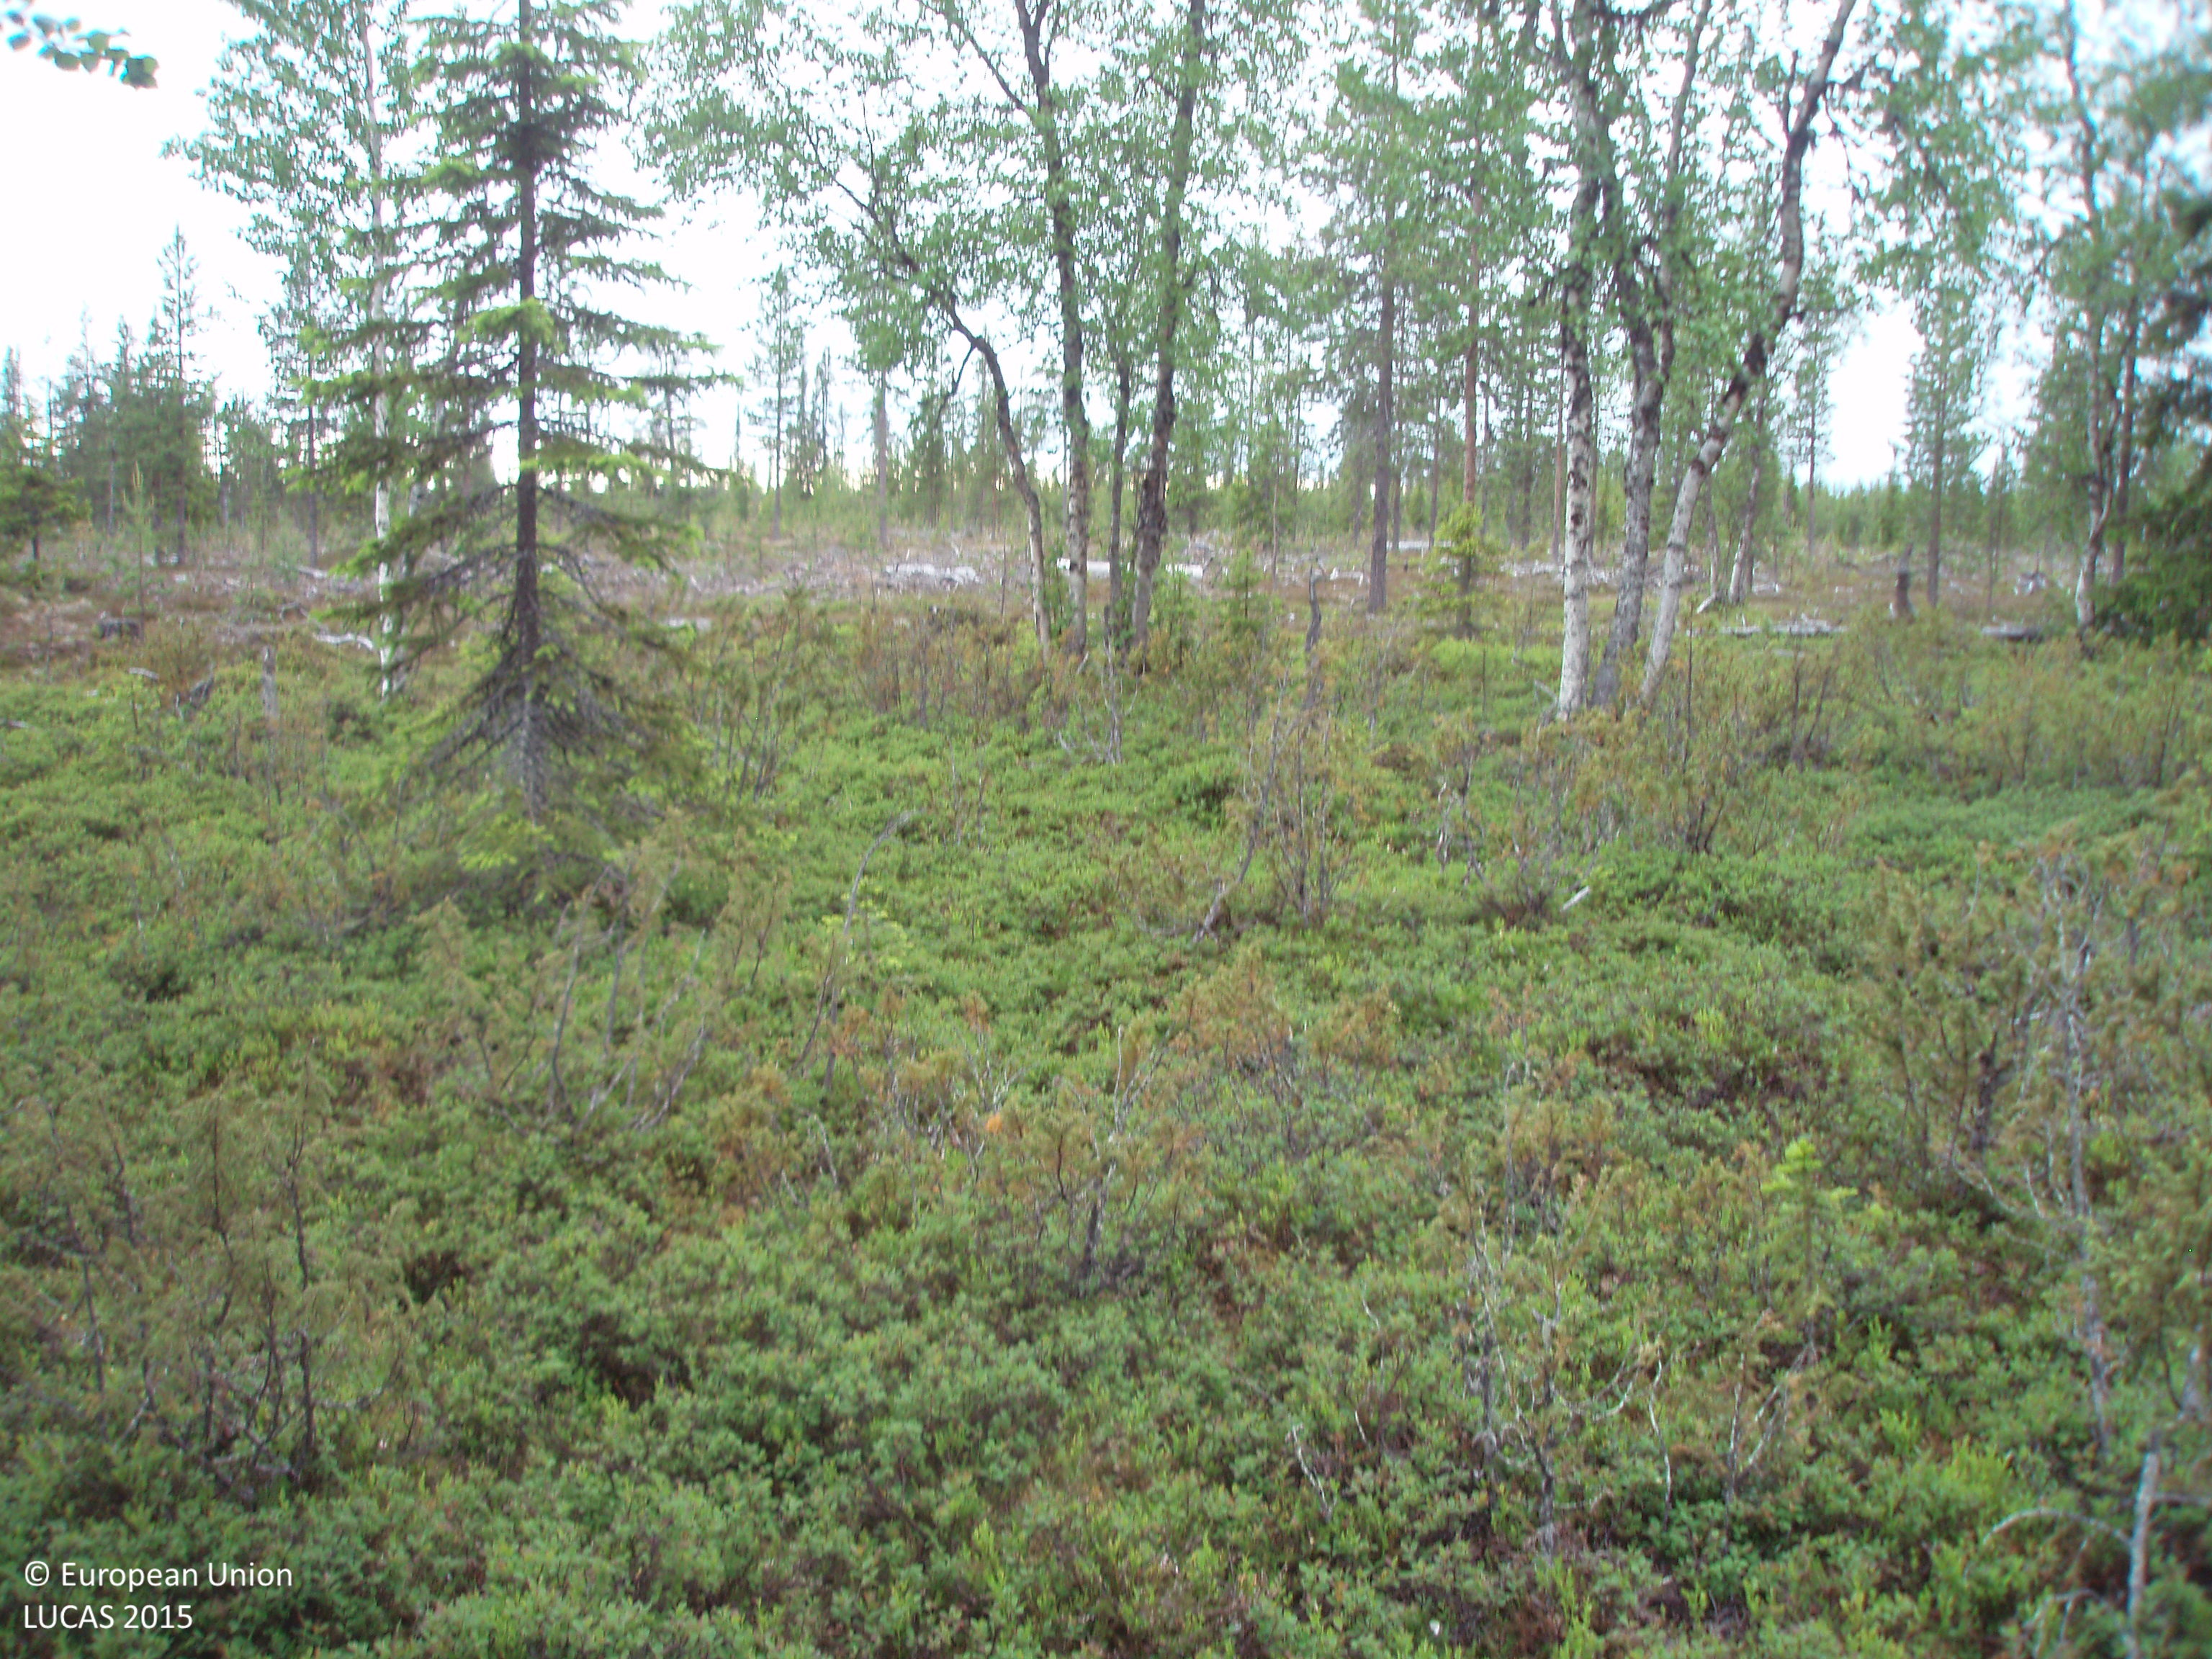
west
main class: Woodland
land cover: Other mixed woodland
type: boreal forest
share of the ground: 25 - 50 %
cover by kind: shrubs 55 %, coniferous forest trees 30 %, broadleaved forest trees 15 %
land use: Forestry
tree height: > 5 m
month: July
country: FI
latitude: 67.8660
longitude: 29.3443
